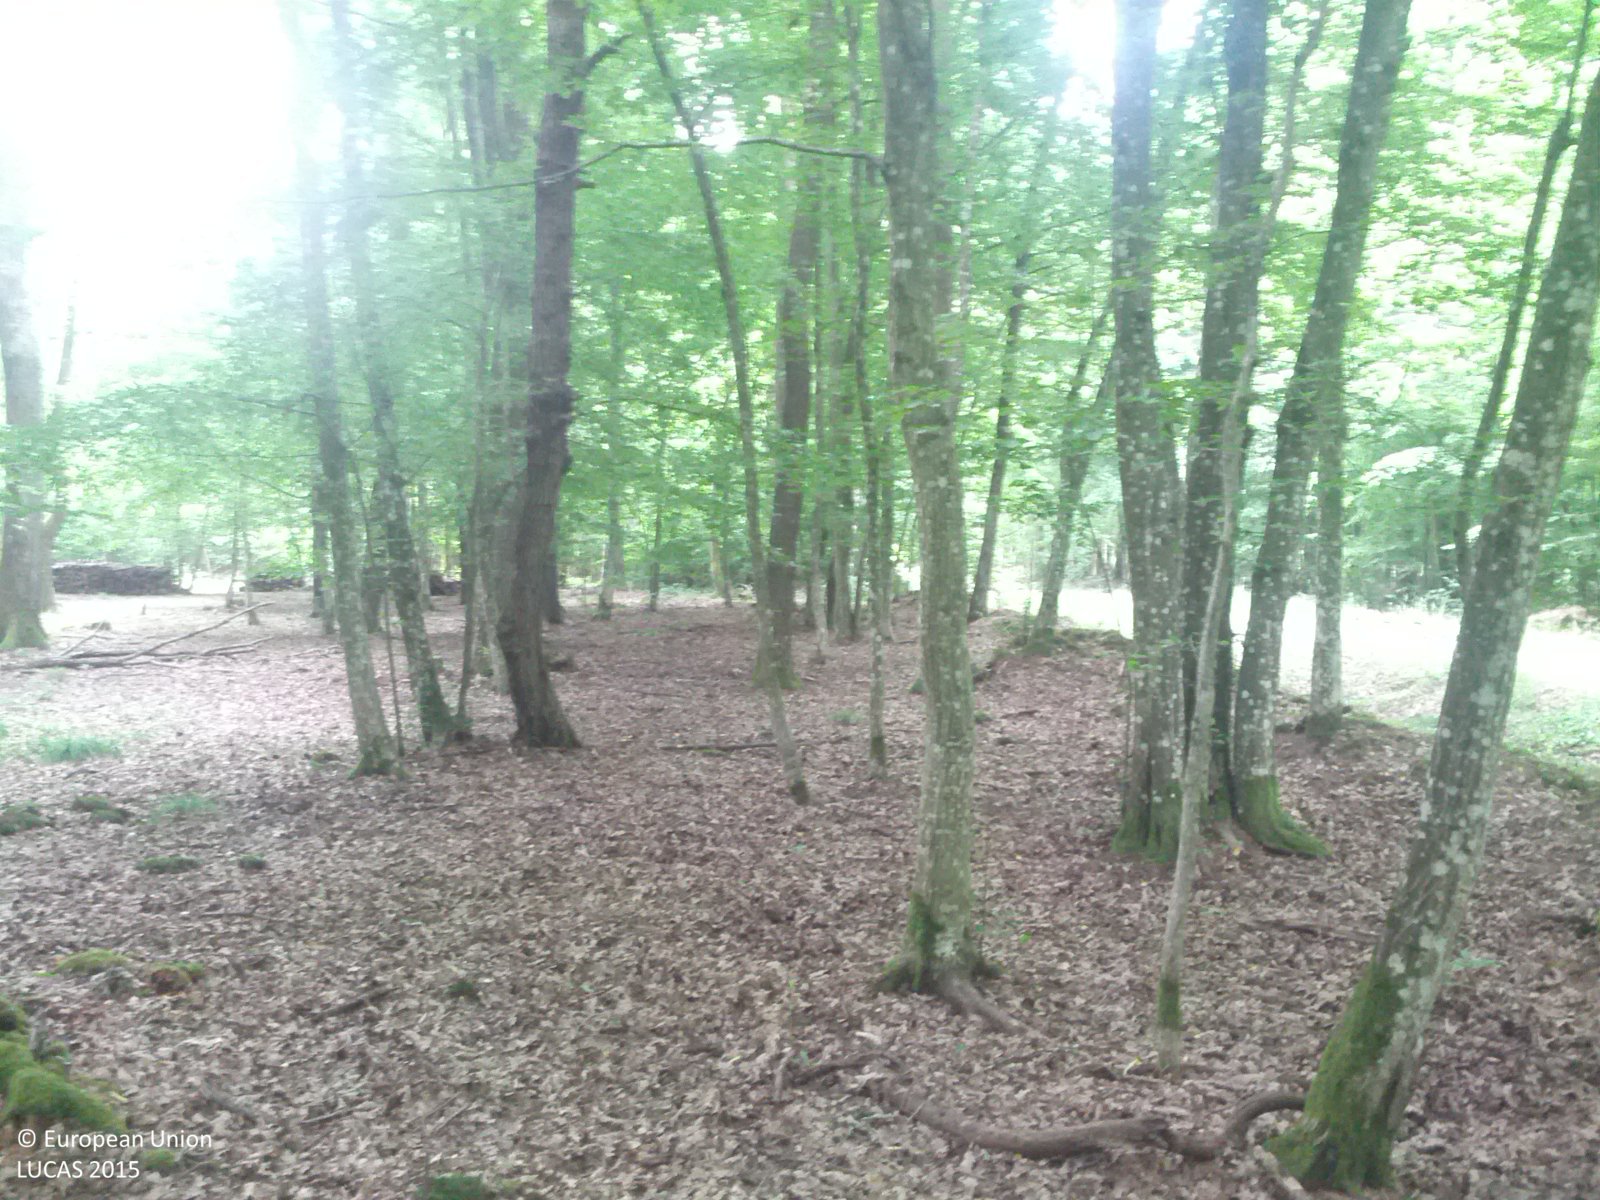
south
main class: Woodland
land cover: Broadleaved woodland
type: beech forest
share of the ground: > 75 %
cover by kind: broadleaved forest trees 90 %, herbaceous plants 5 %, unconsolidated bare surface 5 %
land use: Forestry
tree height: > 5 m
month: June
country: AT
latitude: 47.0812
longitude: 16.3903
